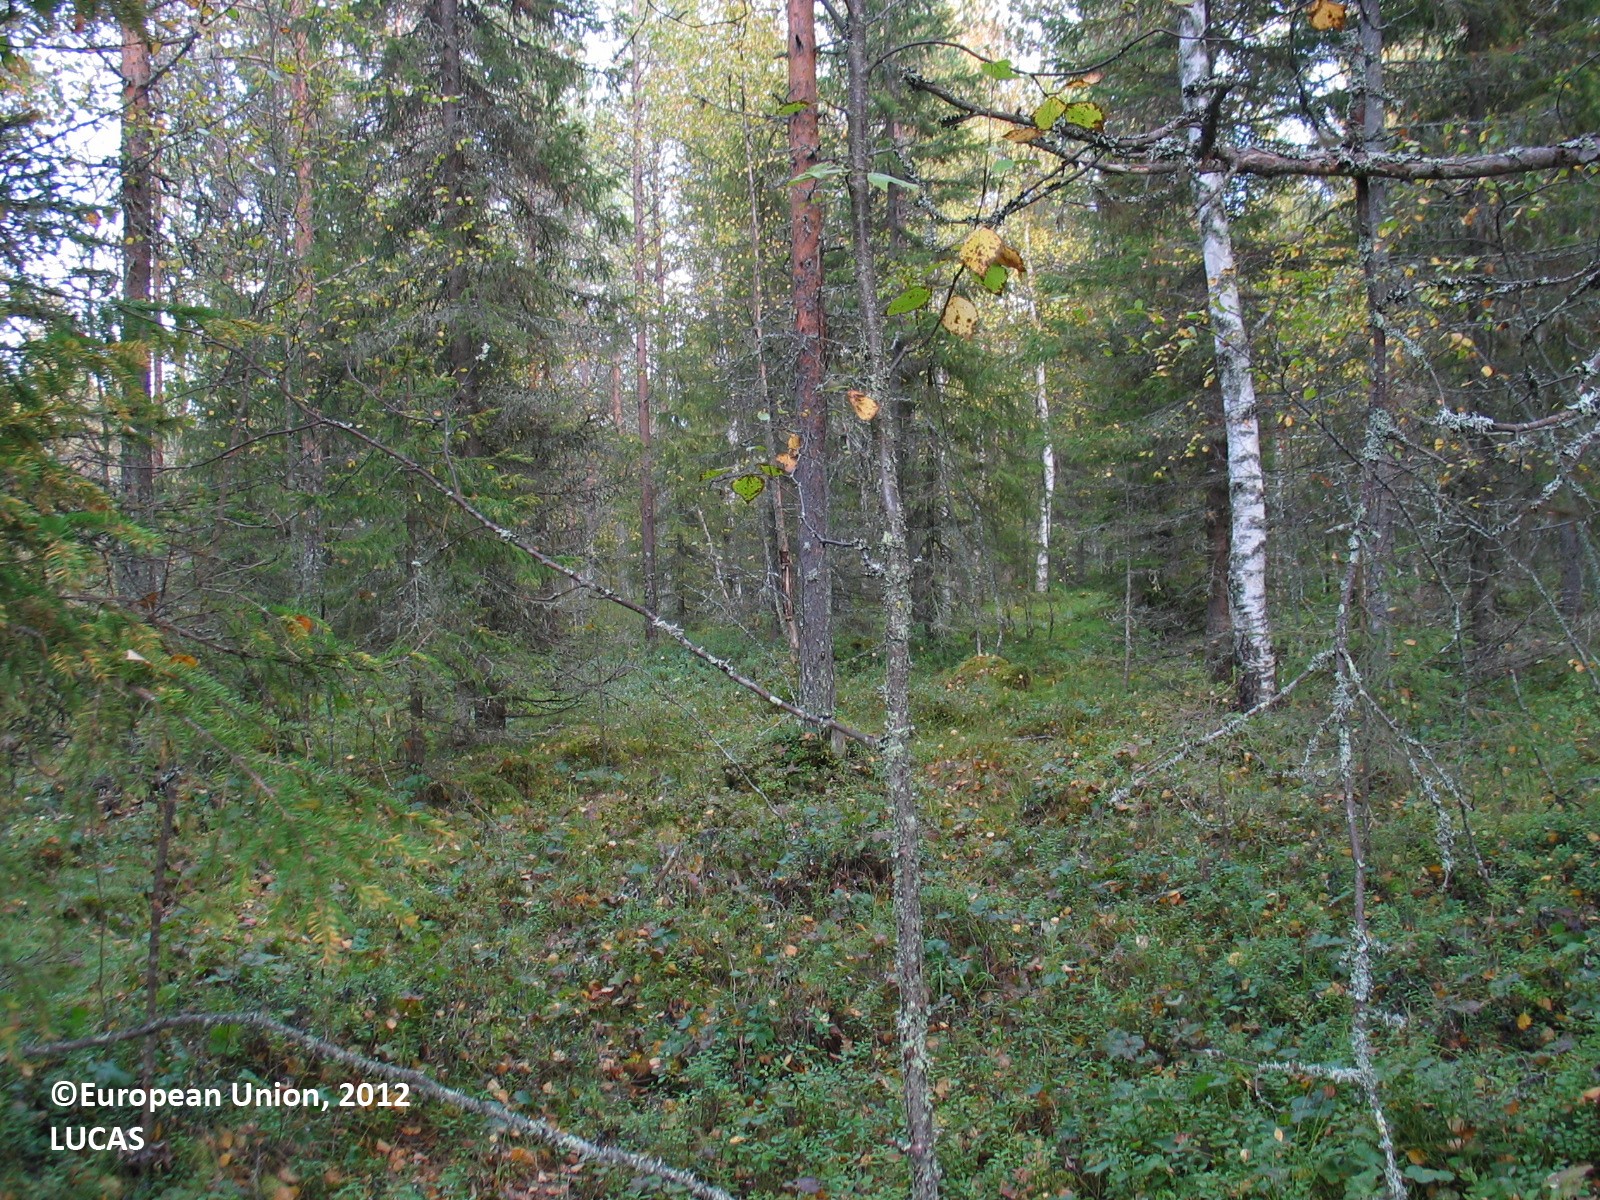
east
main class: Woodland
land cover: Other mixed woodland
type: mire and swamp forests
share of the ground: 25 - 50 %
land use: Forestry
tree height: > 5 m
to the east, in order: Other mixed woodland; Ditches and canals; Pine dominated coniferous woodland; Pine dominated mixed woodland; Pine dominated coniferous woodland; Other coniferous woodland; Ditches and canals; Other coniferous woodland; Ditches and canals; Other coniferous woodland
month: September
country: FI
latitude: 65.6156
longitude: 25.8209
